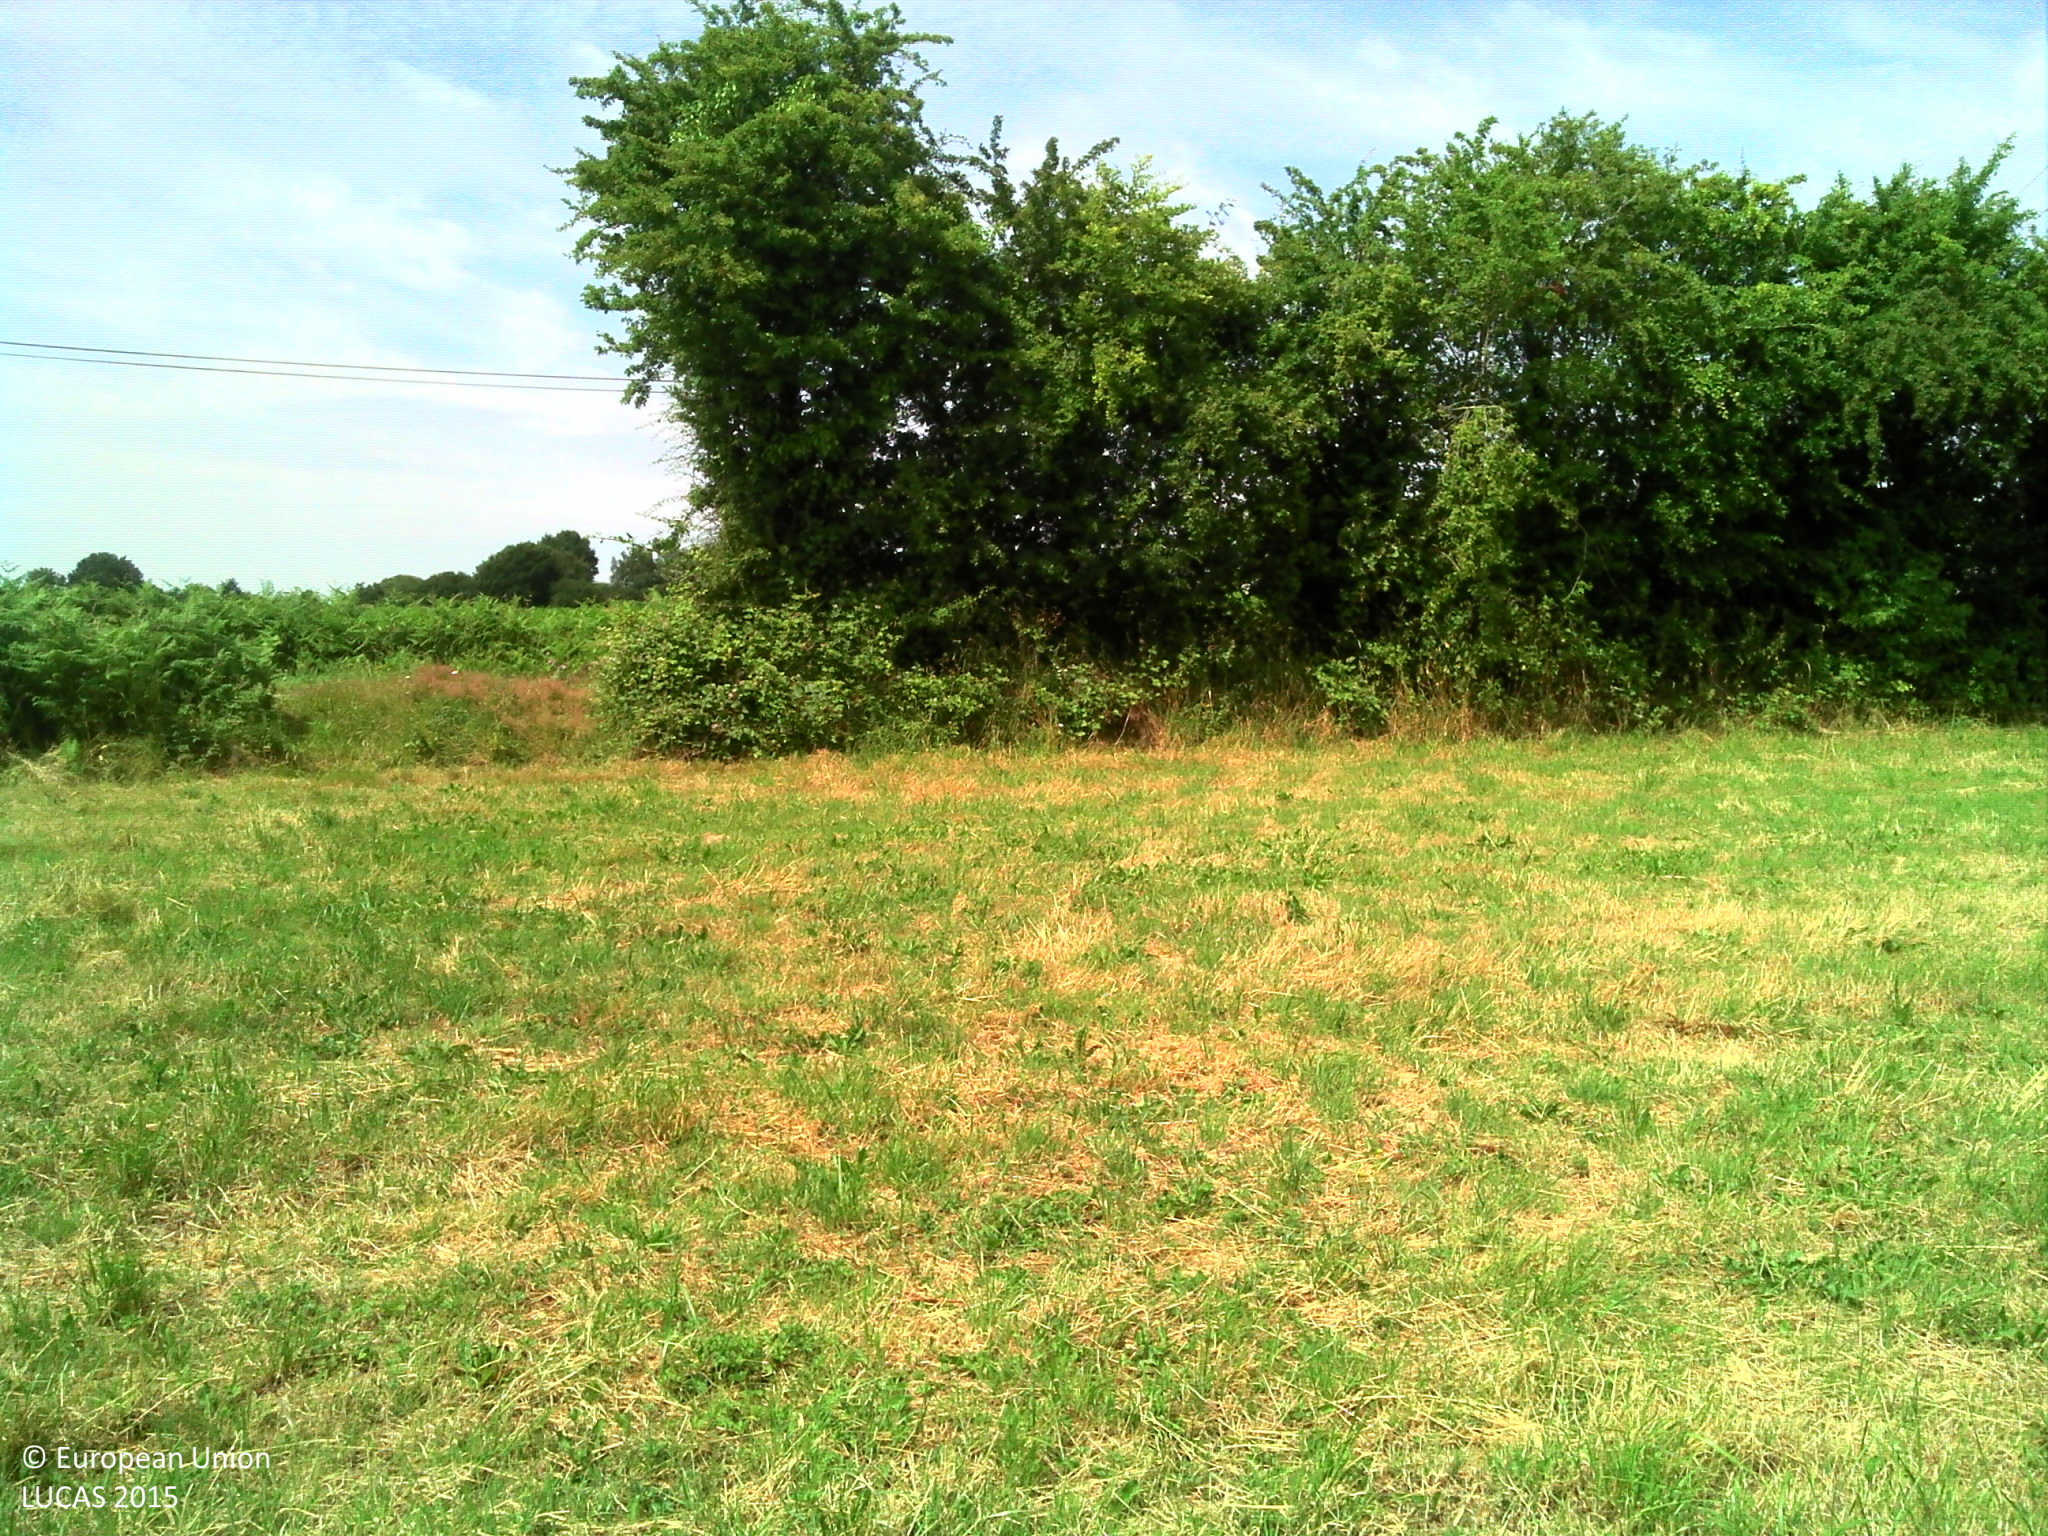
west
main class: Grassland
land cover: Grassland without tree/shrub cover
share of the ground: > 75 %
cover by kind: herbaceous plants 100 %
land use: Agriculture (excluding fallow land and kitchen gardens)
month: June
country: FR
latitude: 47.9229
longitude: -2.0568
